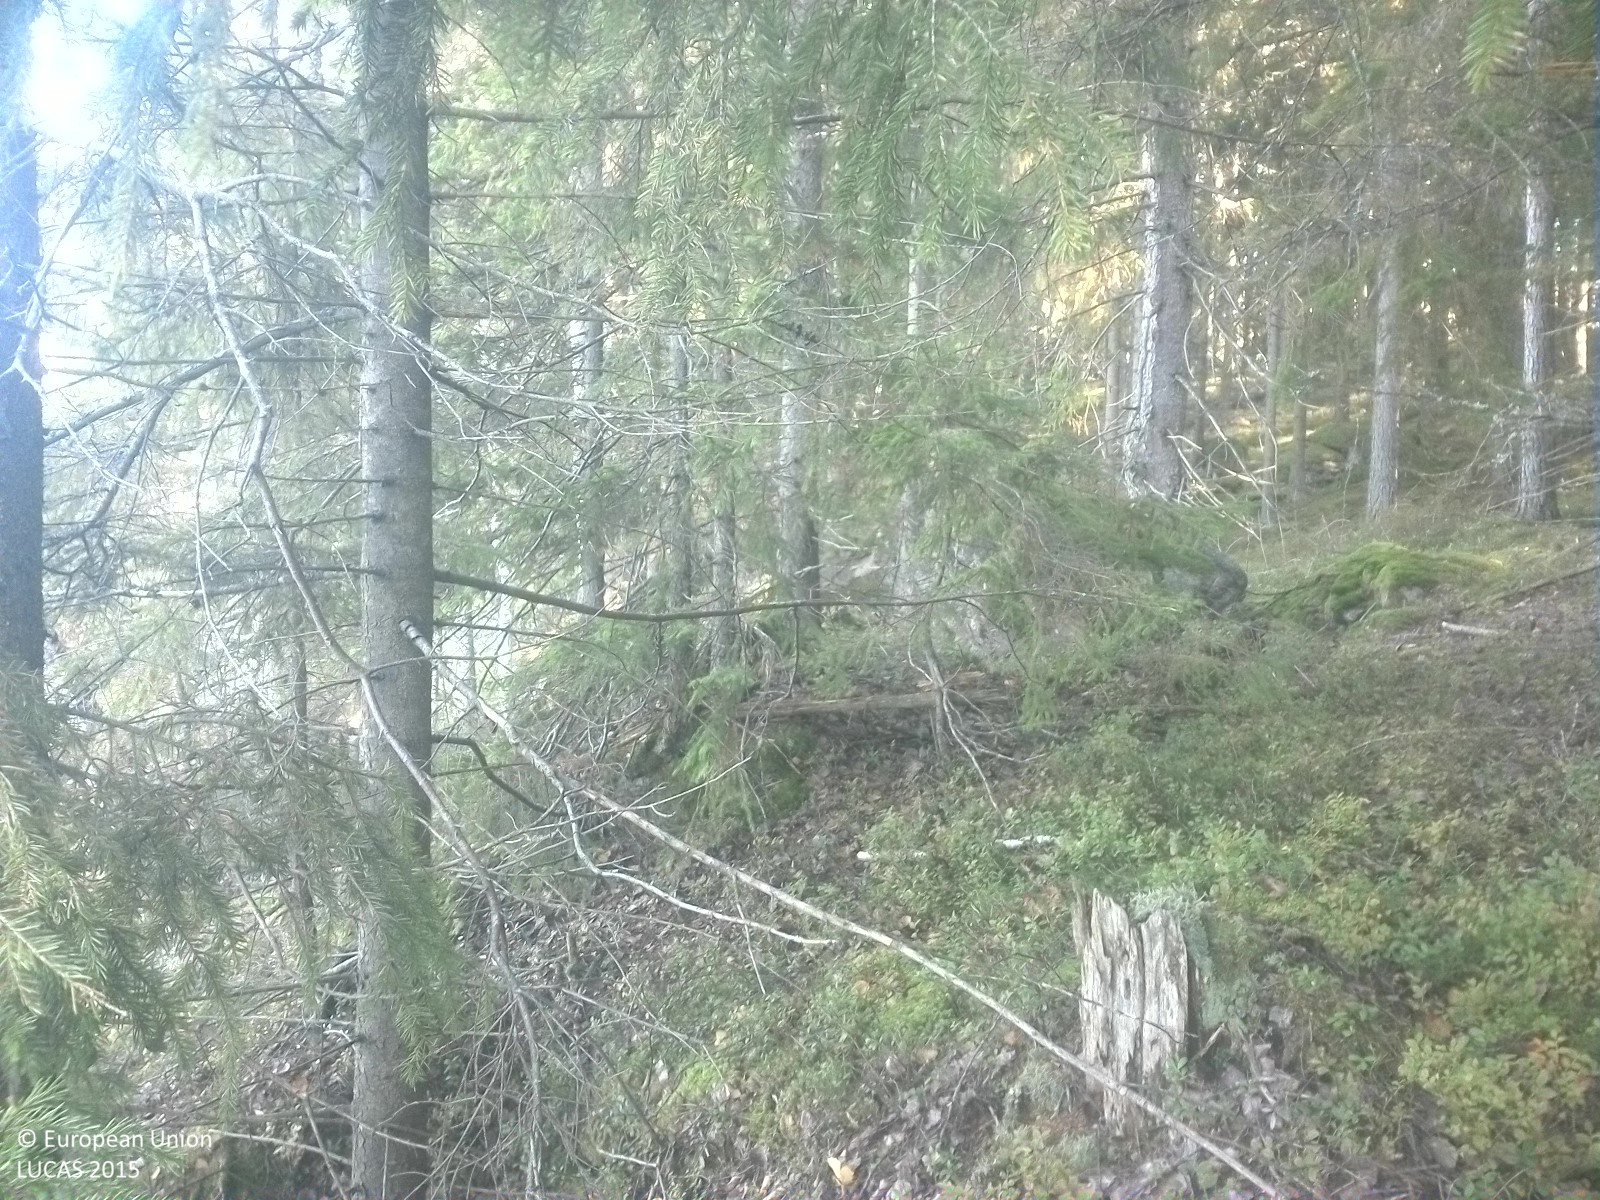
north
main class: Woodland
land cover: Spruce dominated mixed woodland
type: boreal forest
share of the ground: 50 - 75 %
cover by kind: coniferous forest trees 35 %, herbaceous plants 35 %, broadleaved forest trees 20 %, lichens and mosses 10 %
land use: Forestry
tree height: > 5 m
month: September
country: SE
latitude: 58.7607
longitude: 16.2354
